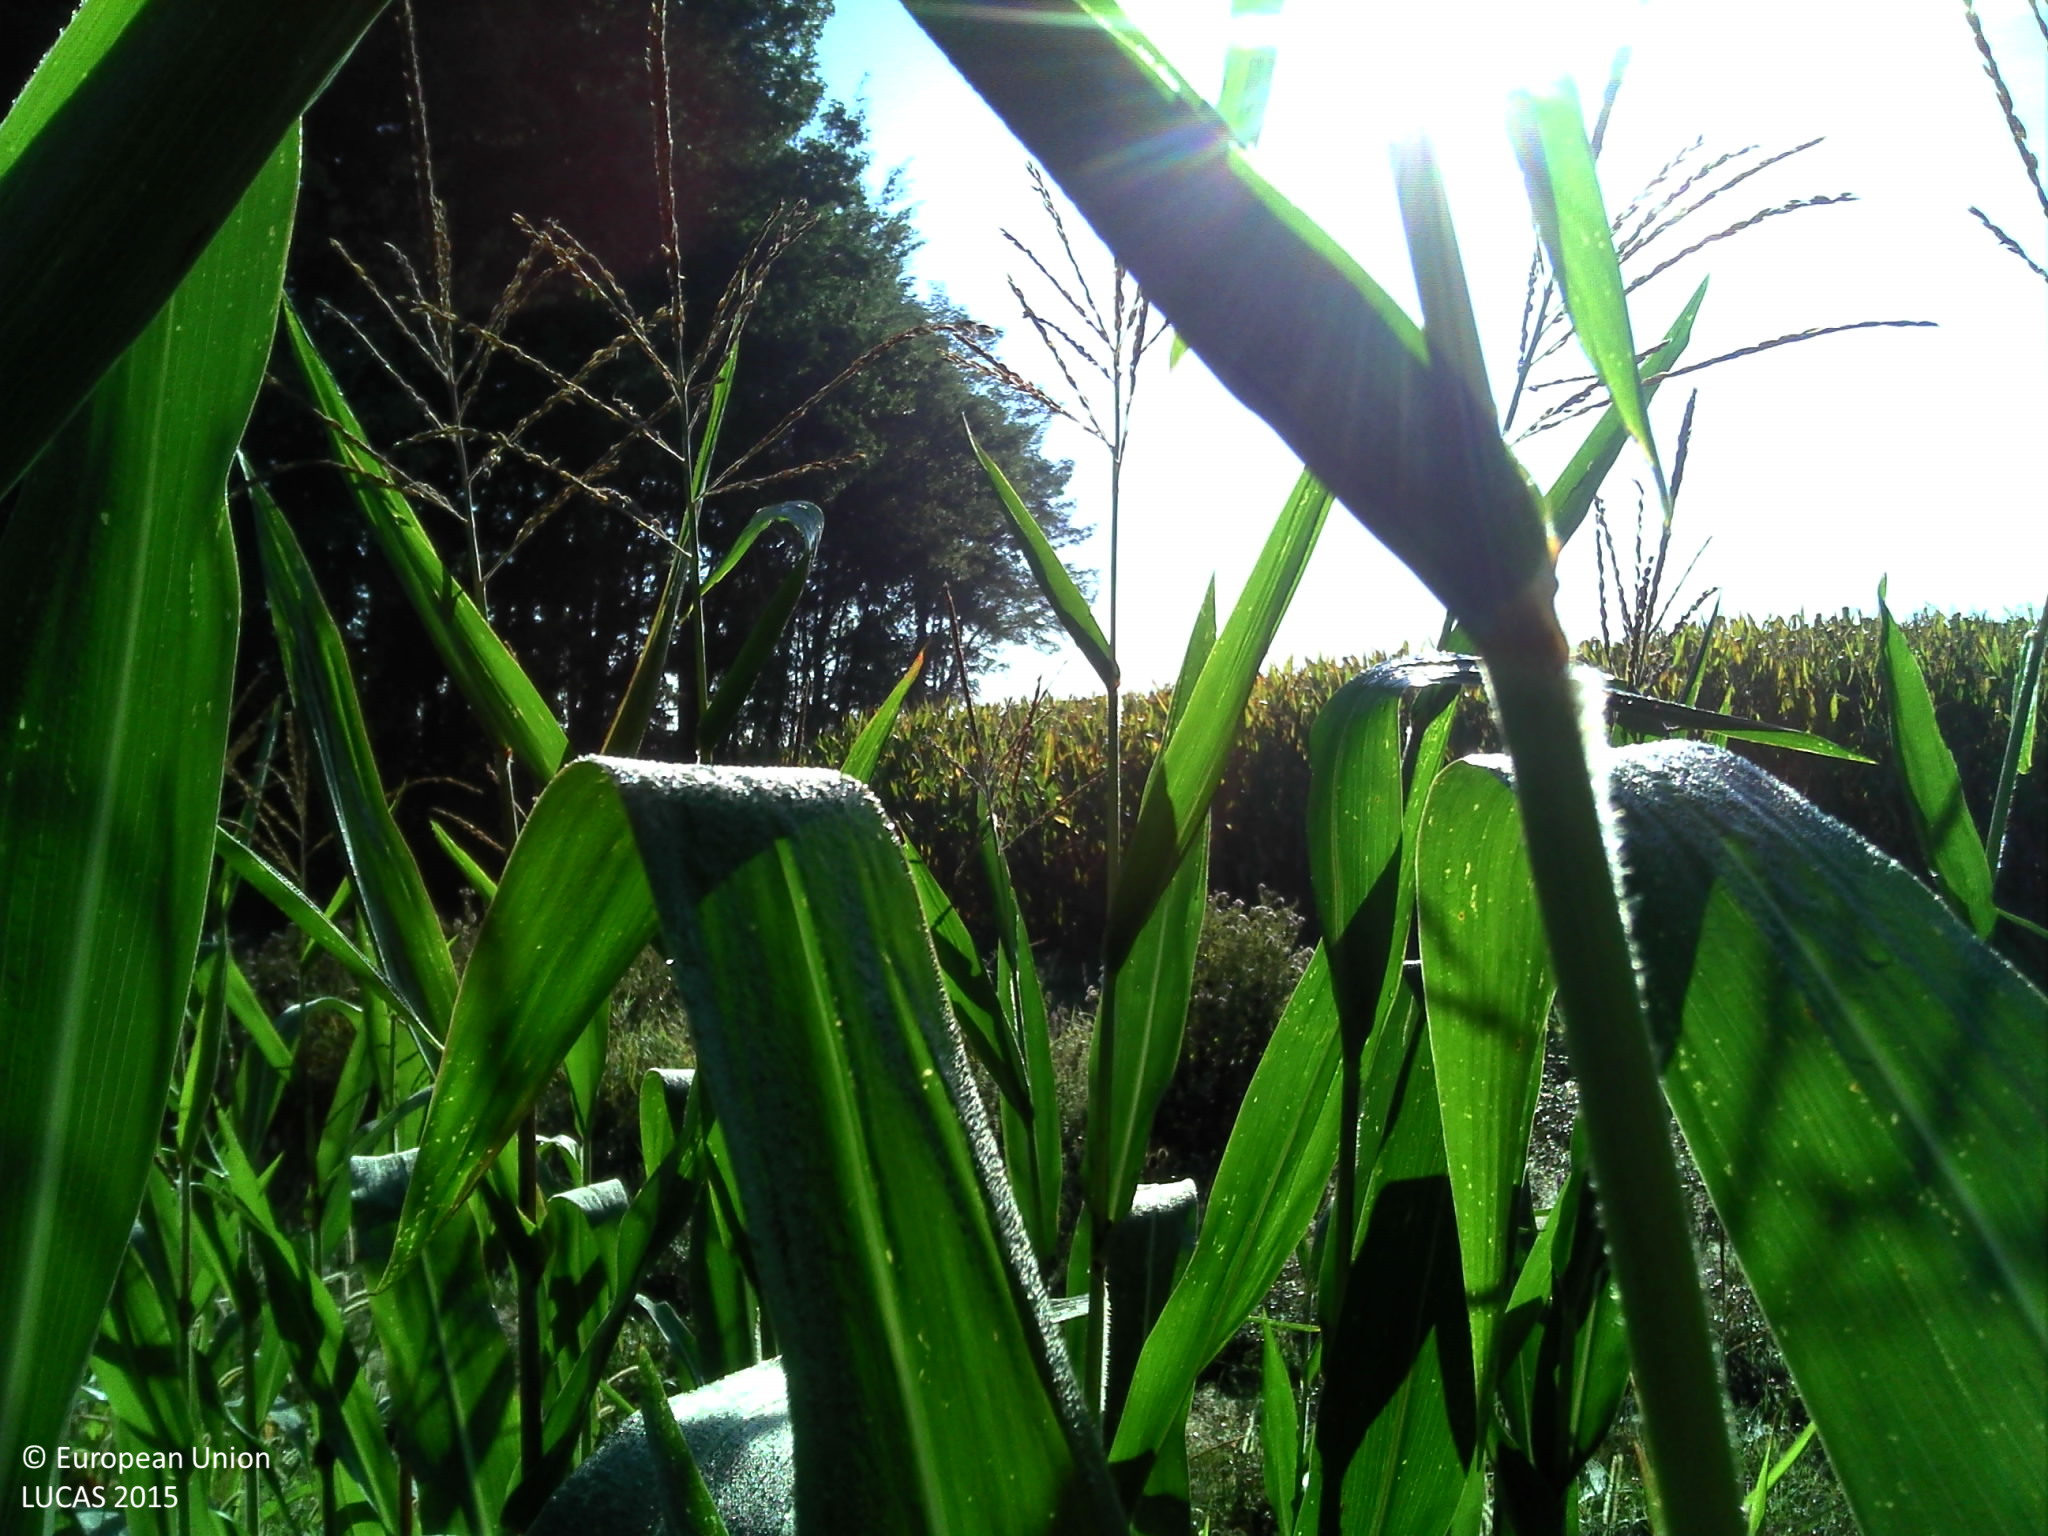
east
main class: Cropland
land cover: Maize
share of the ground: > 75 %
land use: Agriculture (excluding fallow land and kitchen gardens)
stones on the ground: 10 - 25 %
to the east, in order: Maize; Grassland without tree/shrub cover; Shruby margins; Rivers and streams; Grassland without tree/shrub cover; Maize; Spontaneously vegetated surfaces; Ditches and canals; Shruby margins; Maize
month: September
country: FR
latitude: 43.5242
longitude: -0.6884
